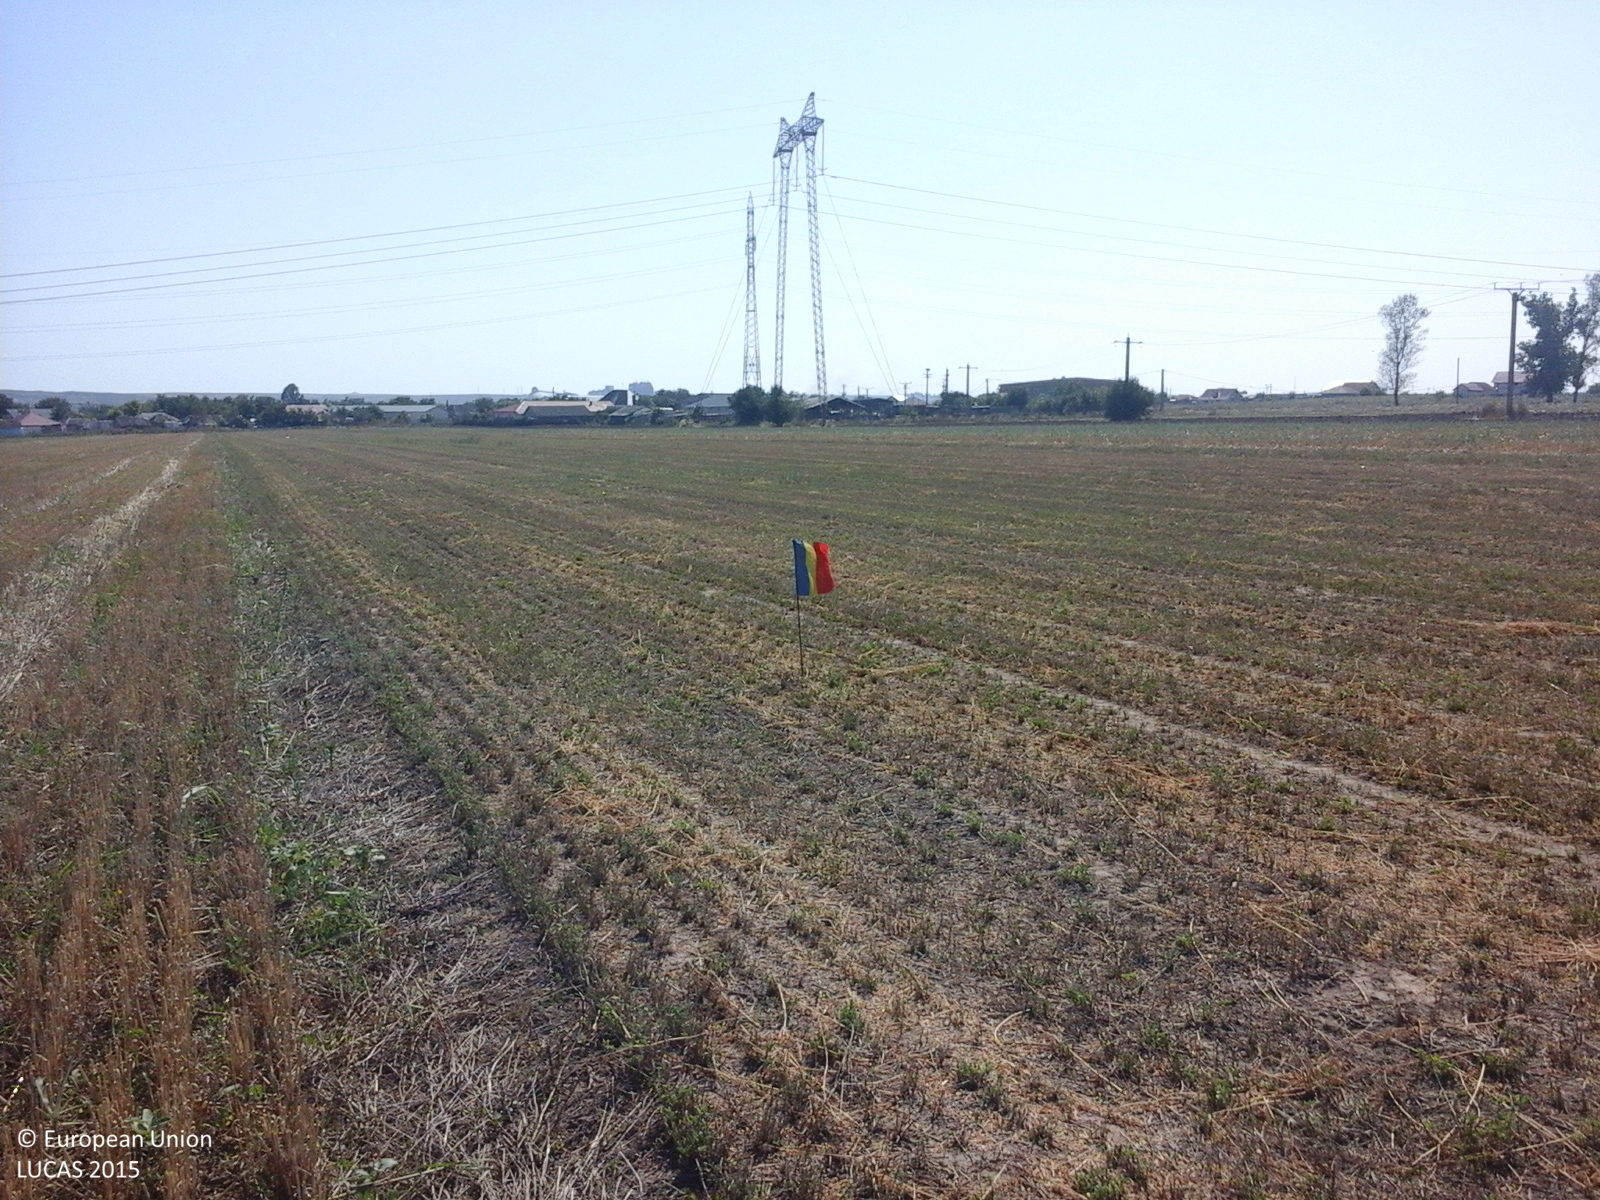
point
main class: Cropland
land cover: Lucerne
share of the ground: 10 - 25 %
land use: Agriculture (excluding fallow land and kitchen gardens)
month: August
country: RO
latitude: 44.2673
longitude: 28.3429
